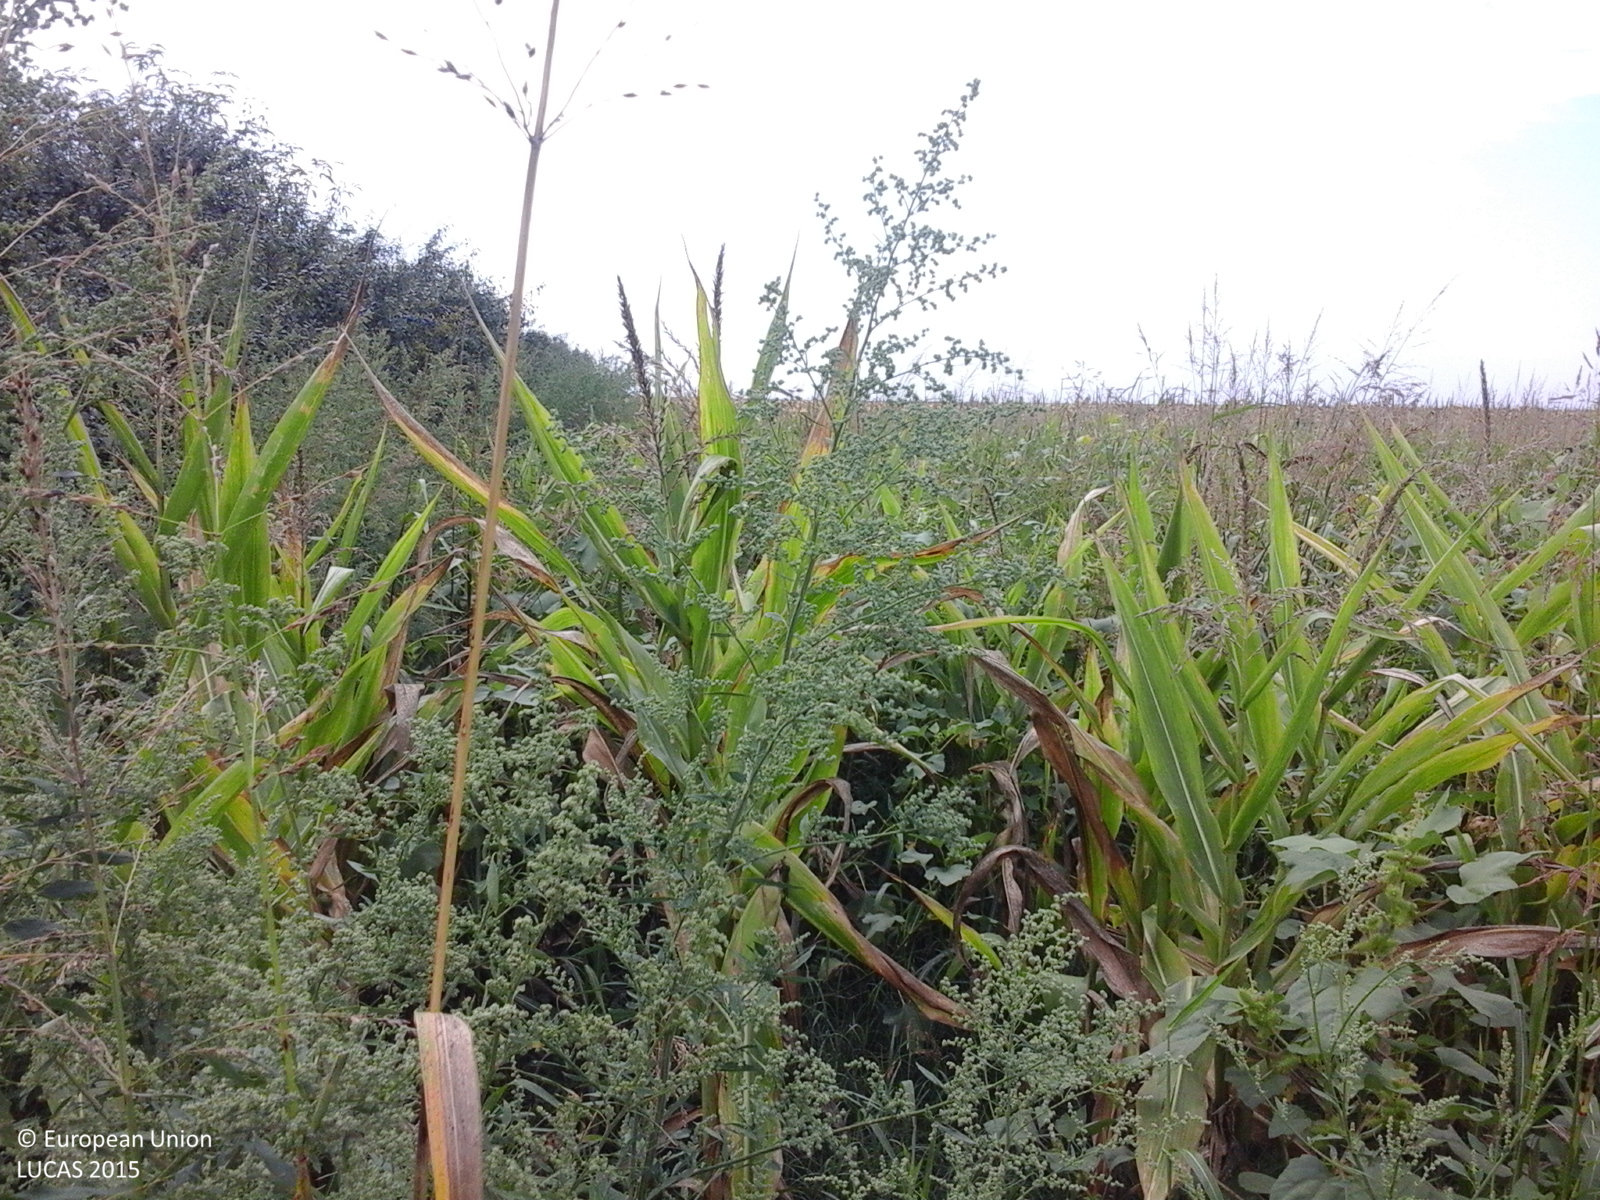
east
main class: Cropland
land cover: Maize
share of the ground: > 75 %
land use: Agriculture (excluding fallow land and kitchen gardens)
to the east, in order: Maize; Sunflower
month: August
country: RO
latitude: 46.2322
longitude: 21.0398
